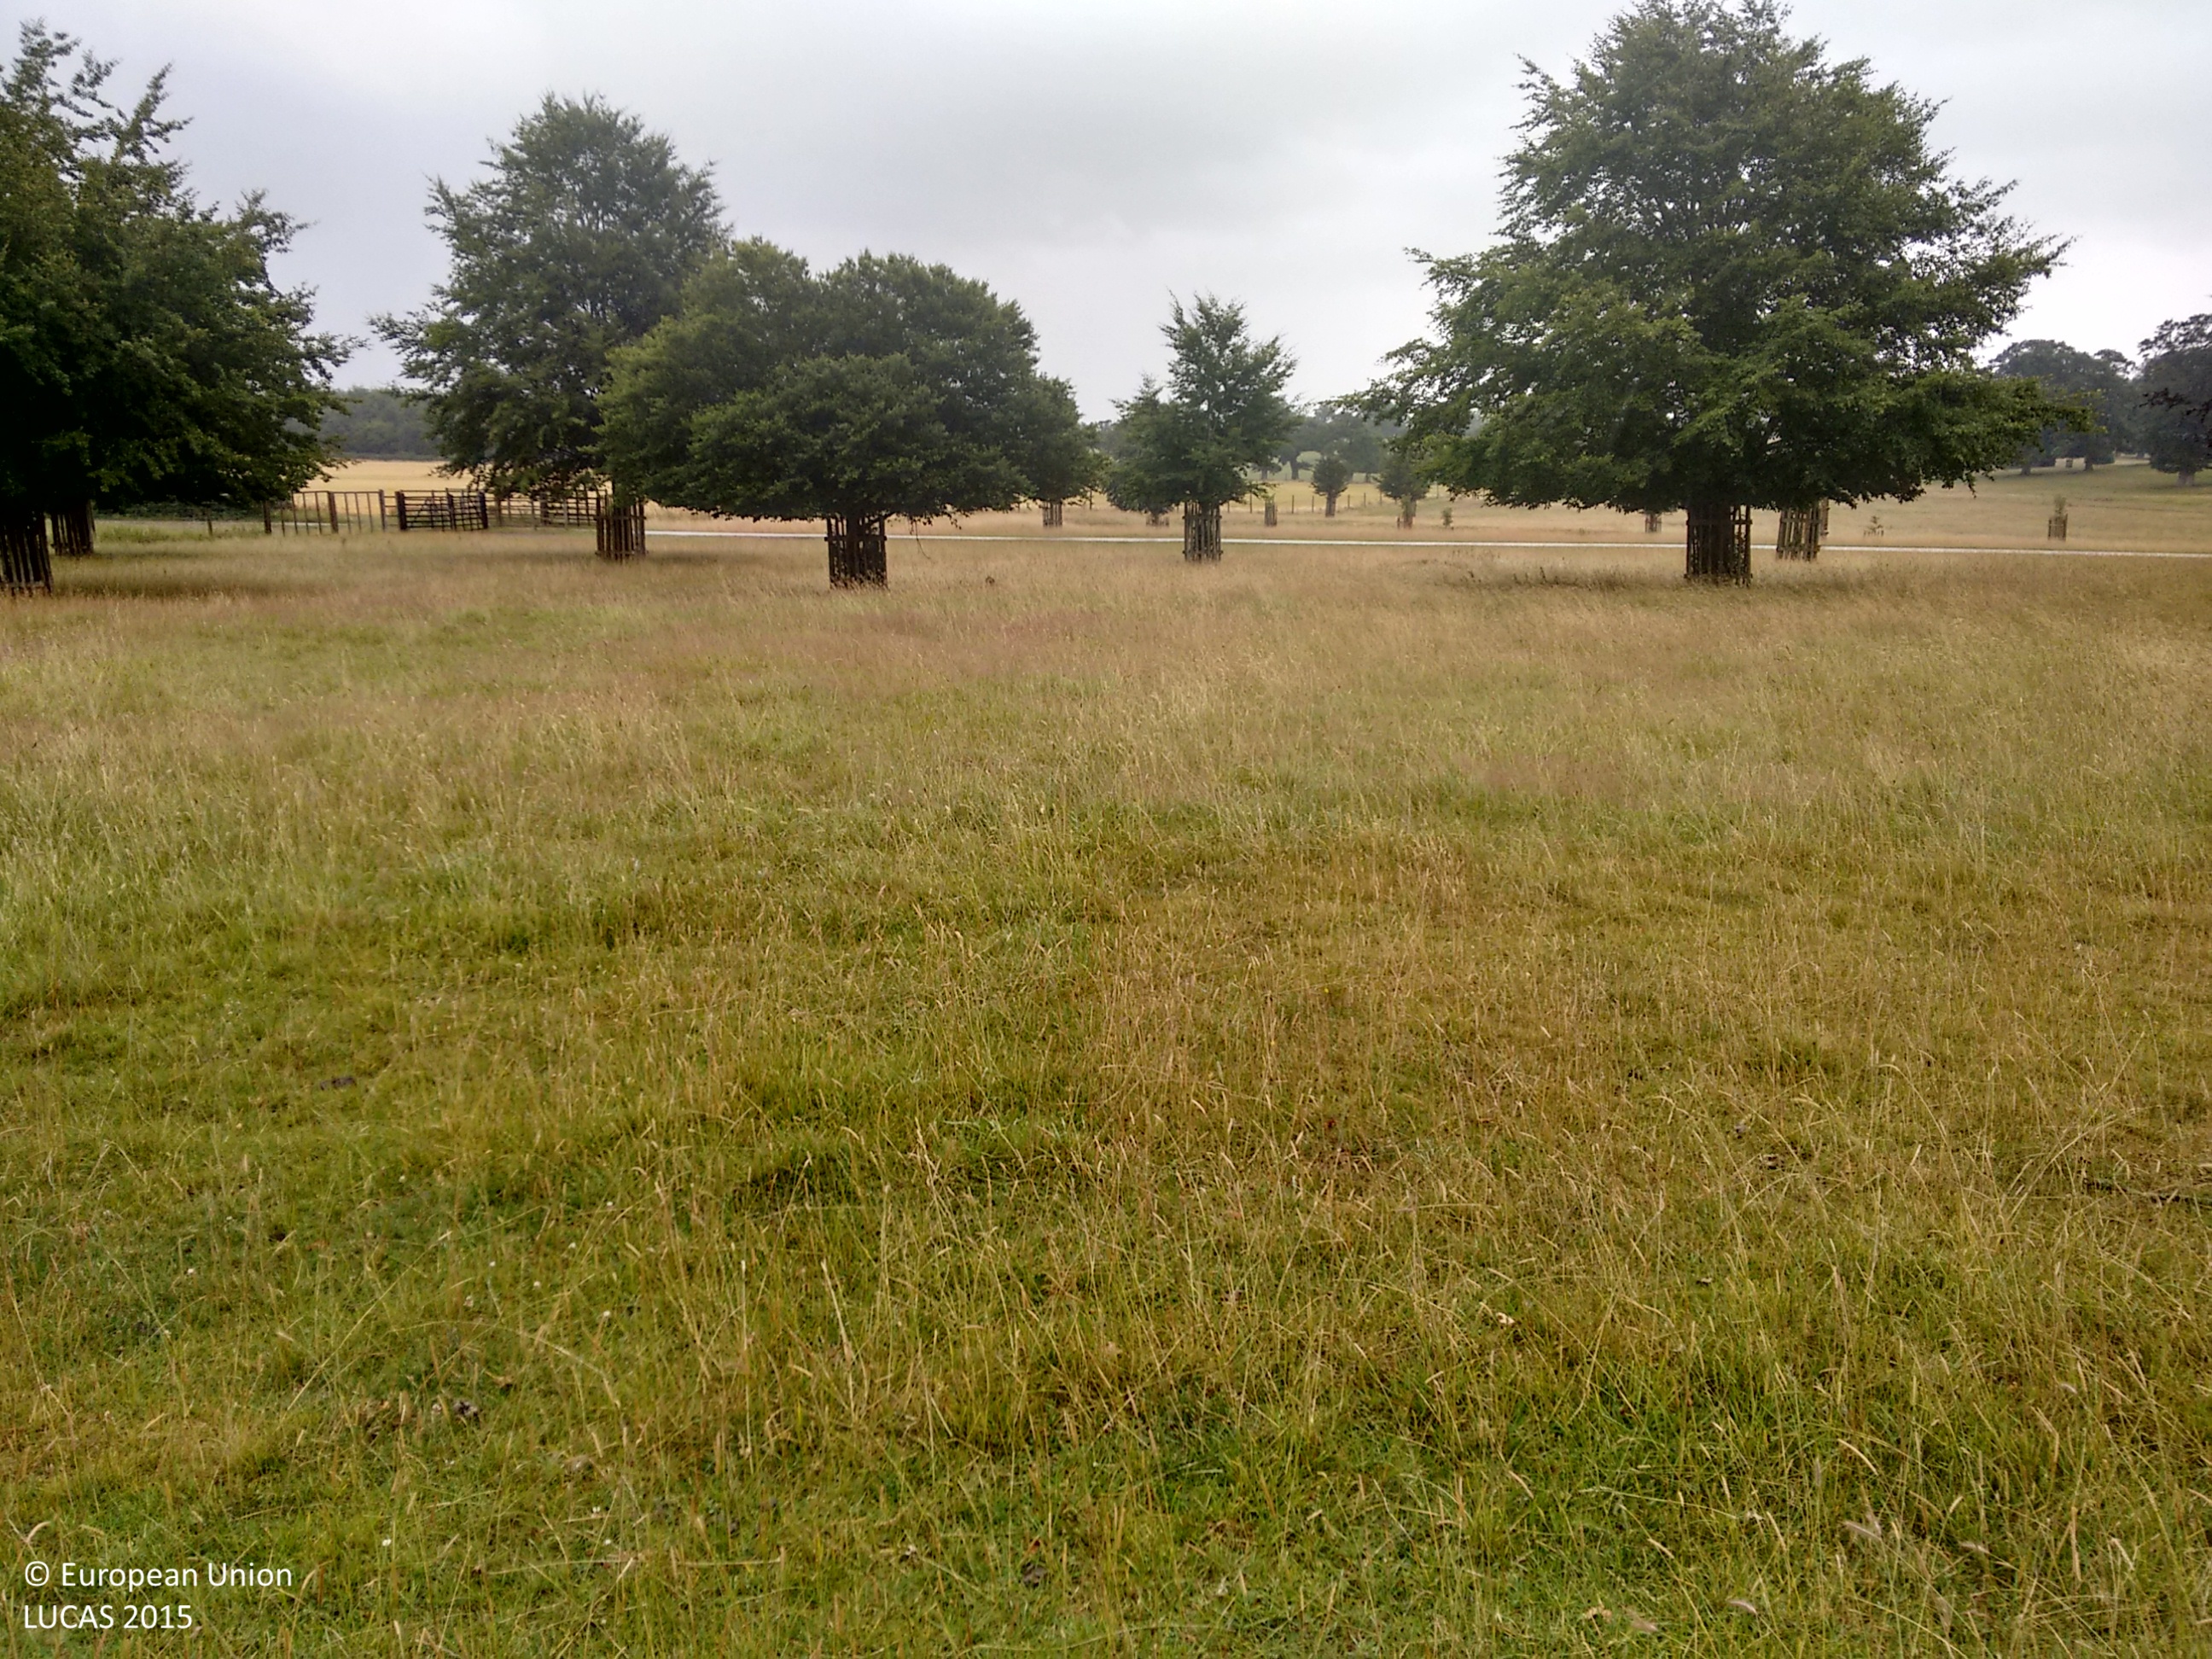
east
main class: Grassland
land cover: Grassland without tree/shrub cover
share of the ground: > 75 %
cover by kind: herbaceous plants 100 %
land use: Amenities, museums, leisure
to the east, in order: Grassland without tree/shrub cover; Lines of trees; Grassland with sparse tree/shrub cover; Paved roads, cycling and walking lanes; Grassland with sparse tree/shrub cover; Fences; Common wheat
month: July
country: GB
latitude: 51.5551
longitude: -2.2791
